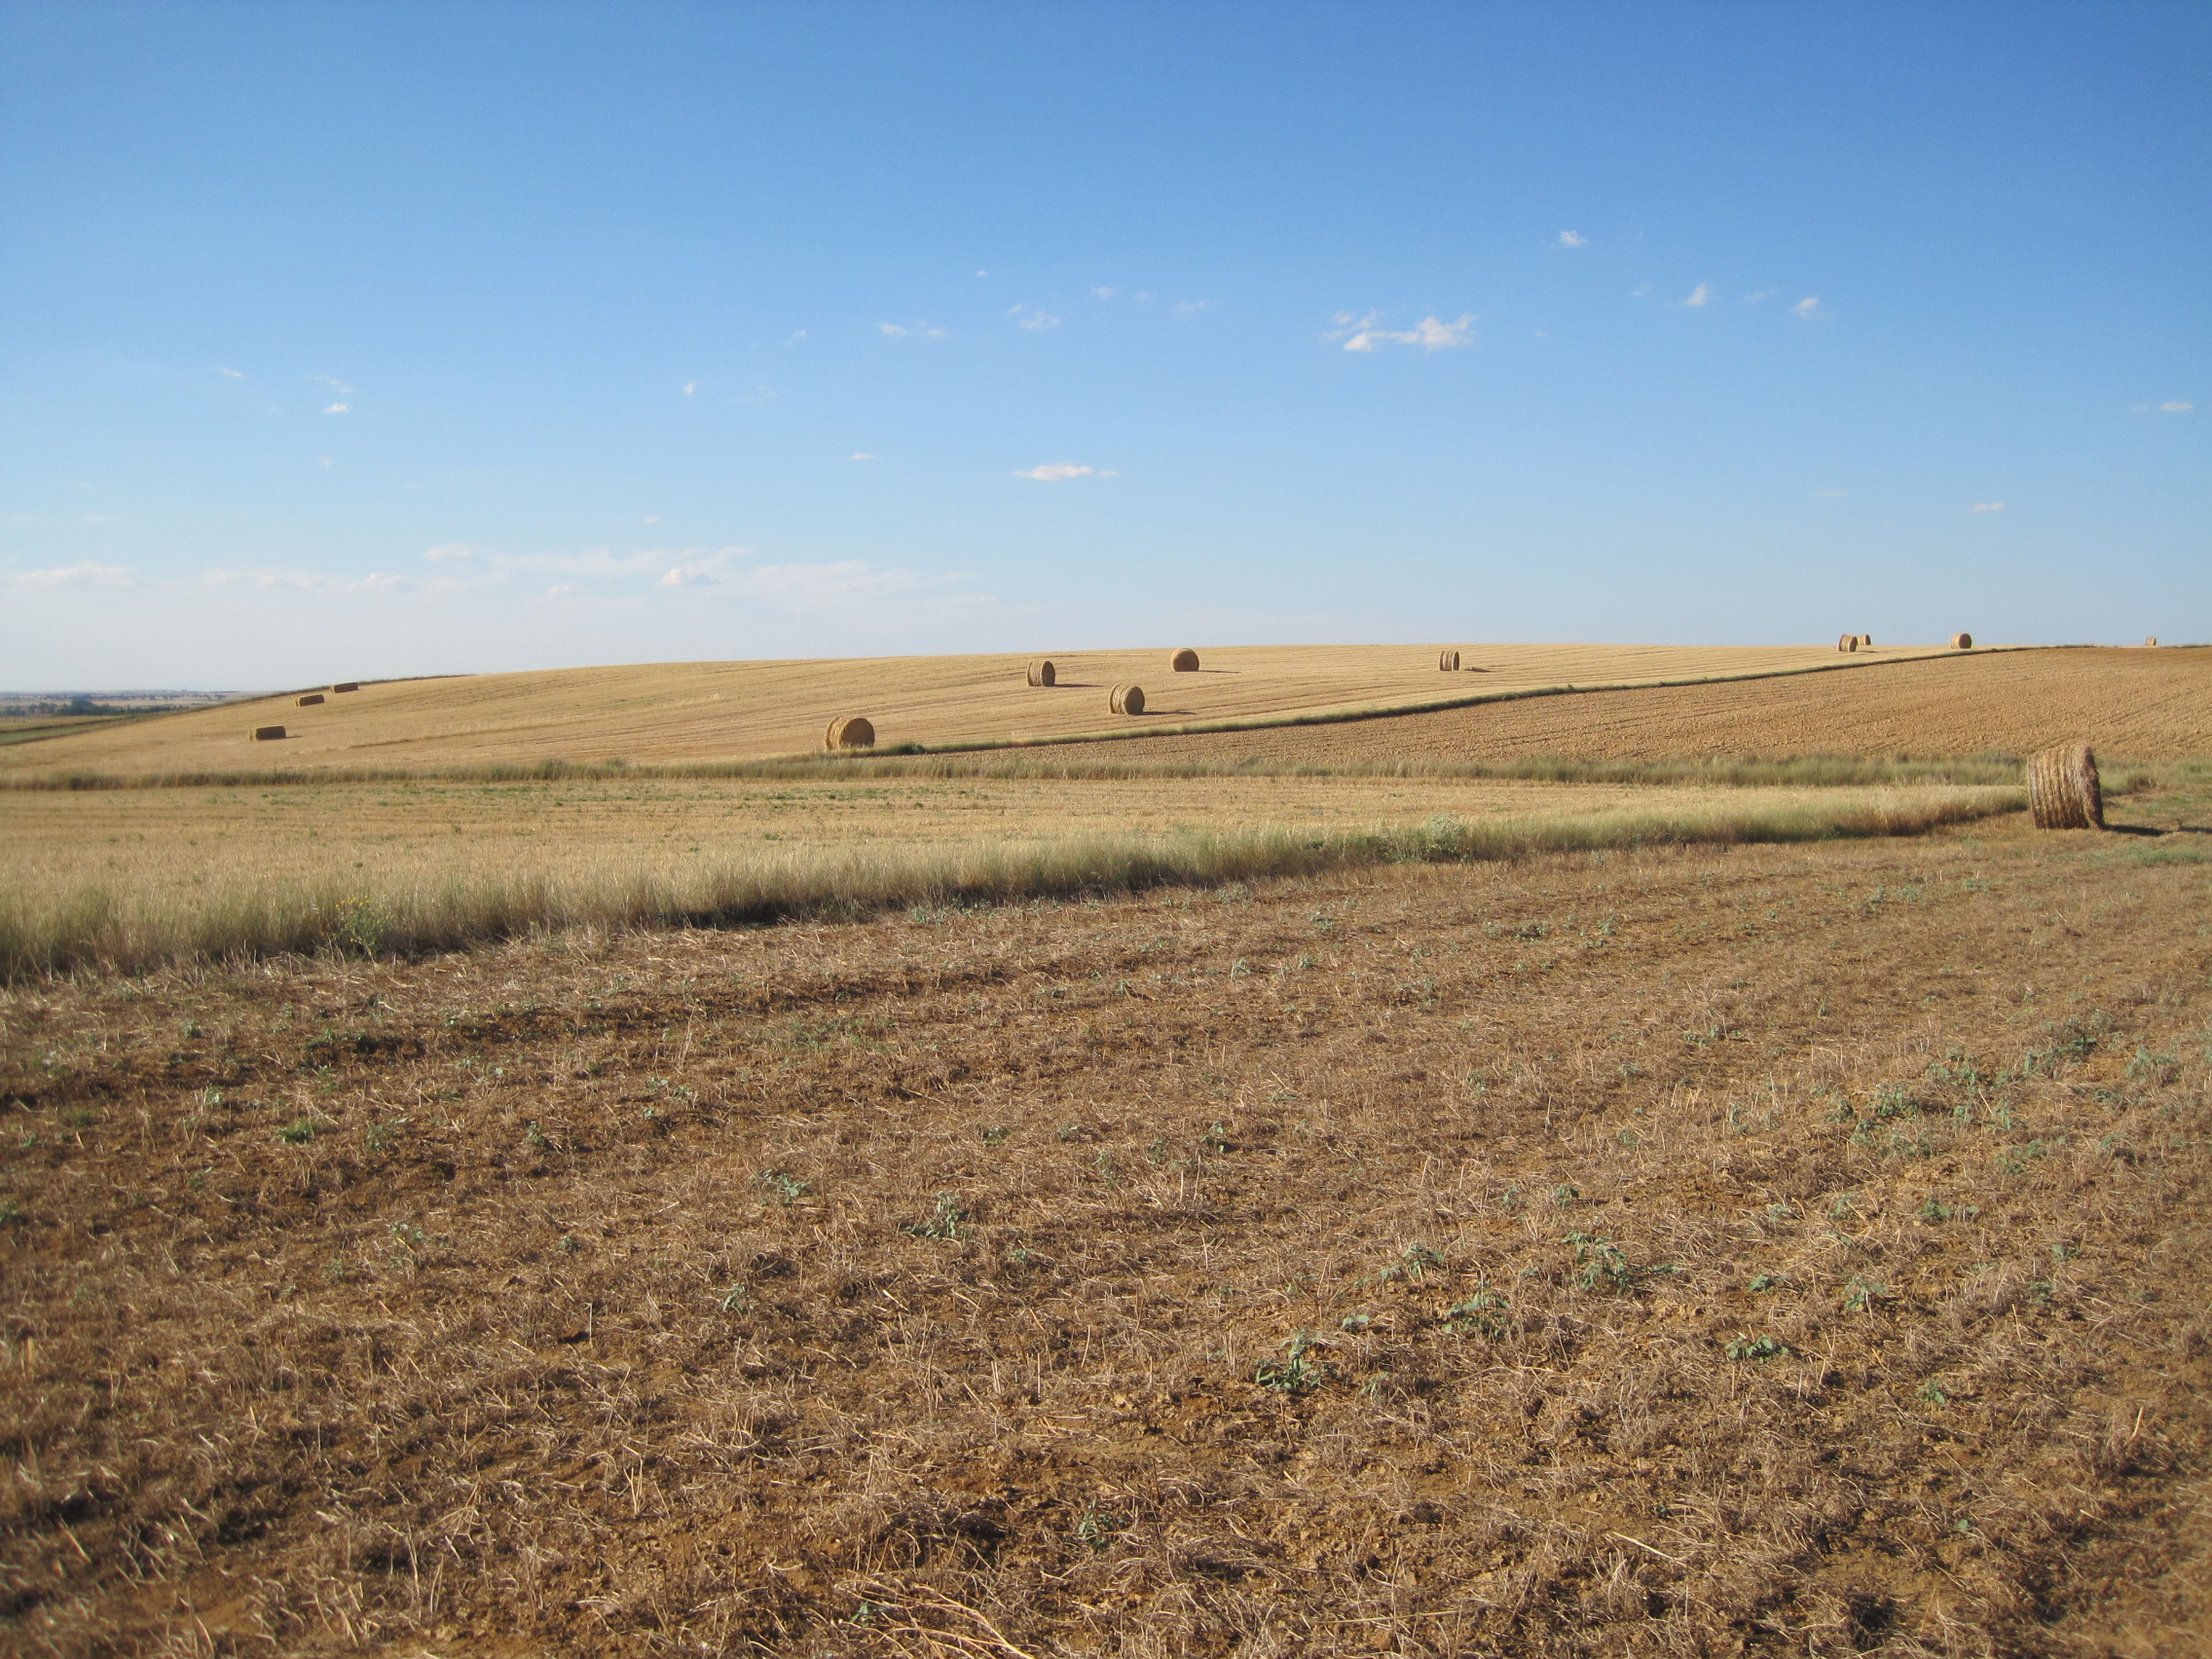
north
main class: Cropland
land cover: Dry pulses
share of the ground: < 10 %
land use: Agriculture (excluding fallow land and kitchen gardens)
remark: Harvested field
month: July
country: ES
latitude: 42.1521
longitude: -5.2485
